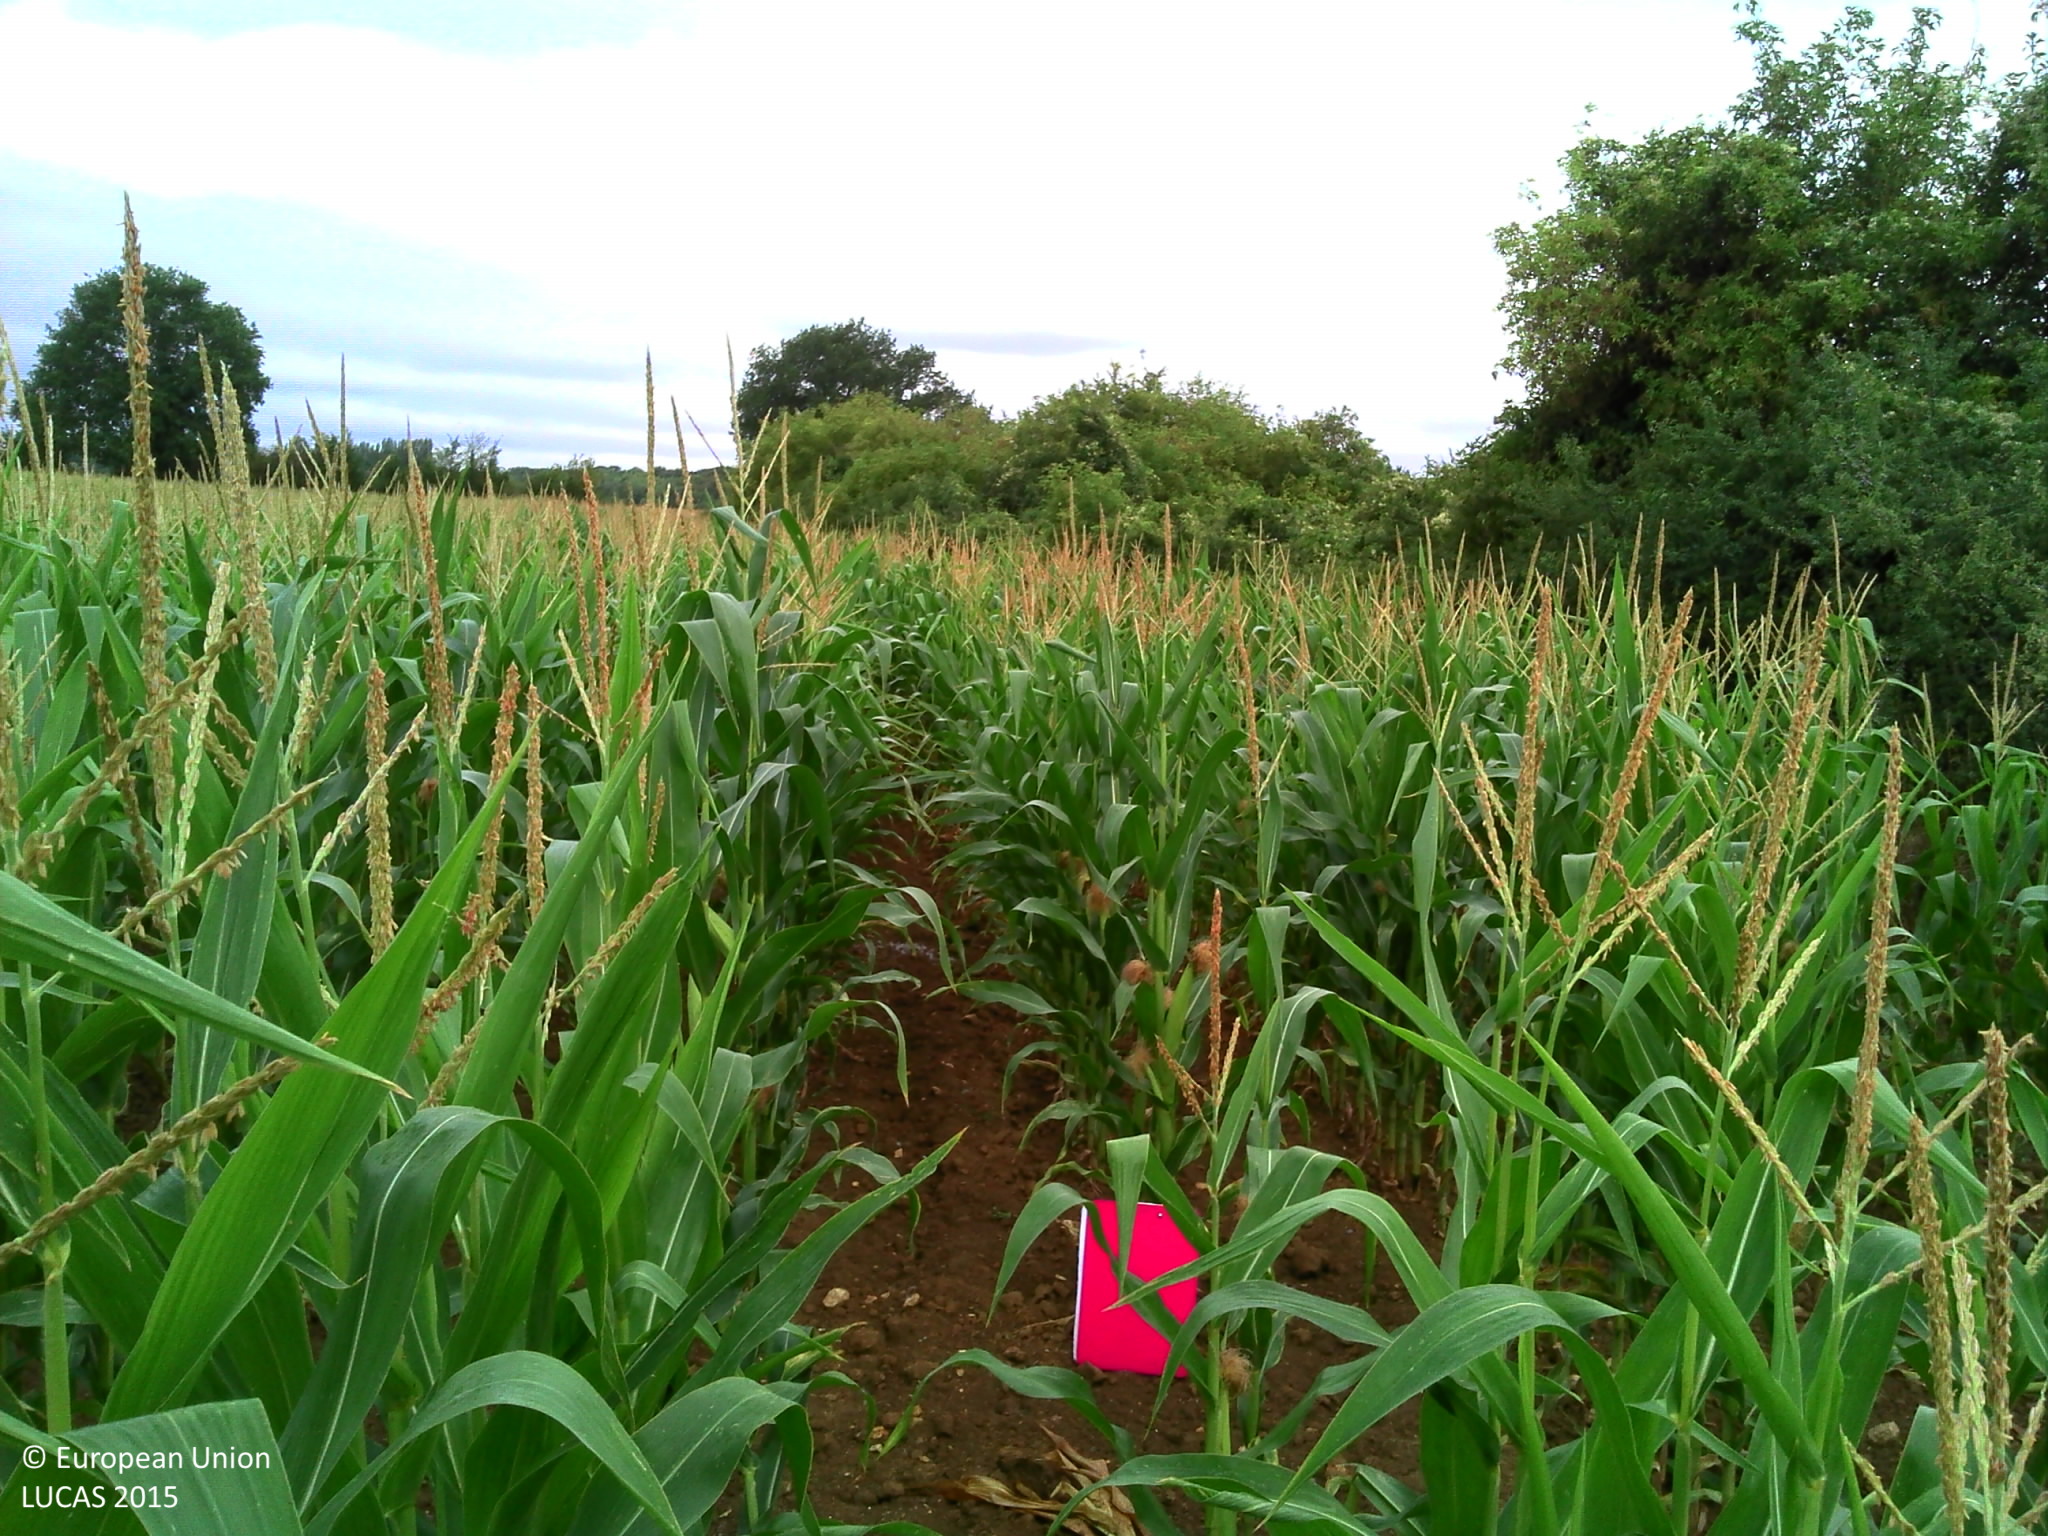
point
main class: Cropland
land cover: Maize
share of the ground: > 75 %
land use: Agriculture (excluding fallow land and kitchen gardens)
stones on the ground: < 10 %
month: July
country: FR
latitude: 49.2204
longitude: 2.5885
